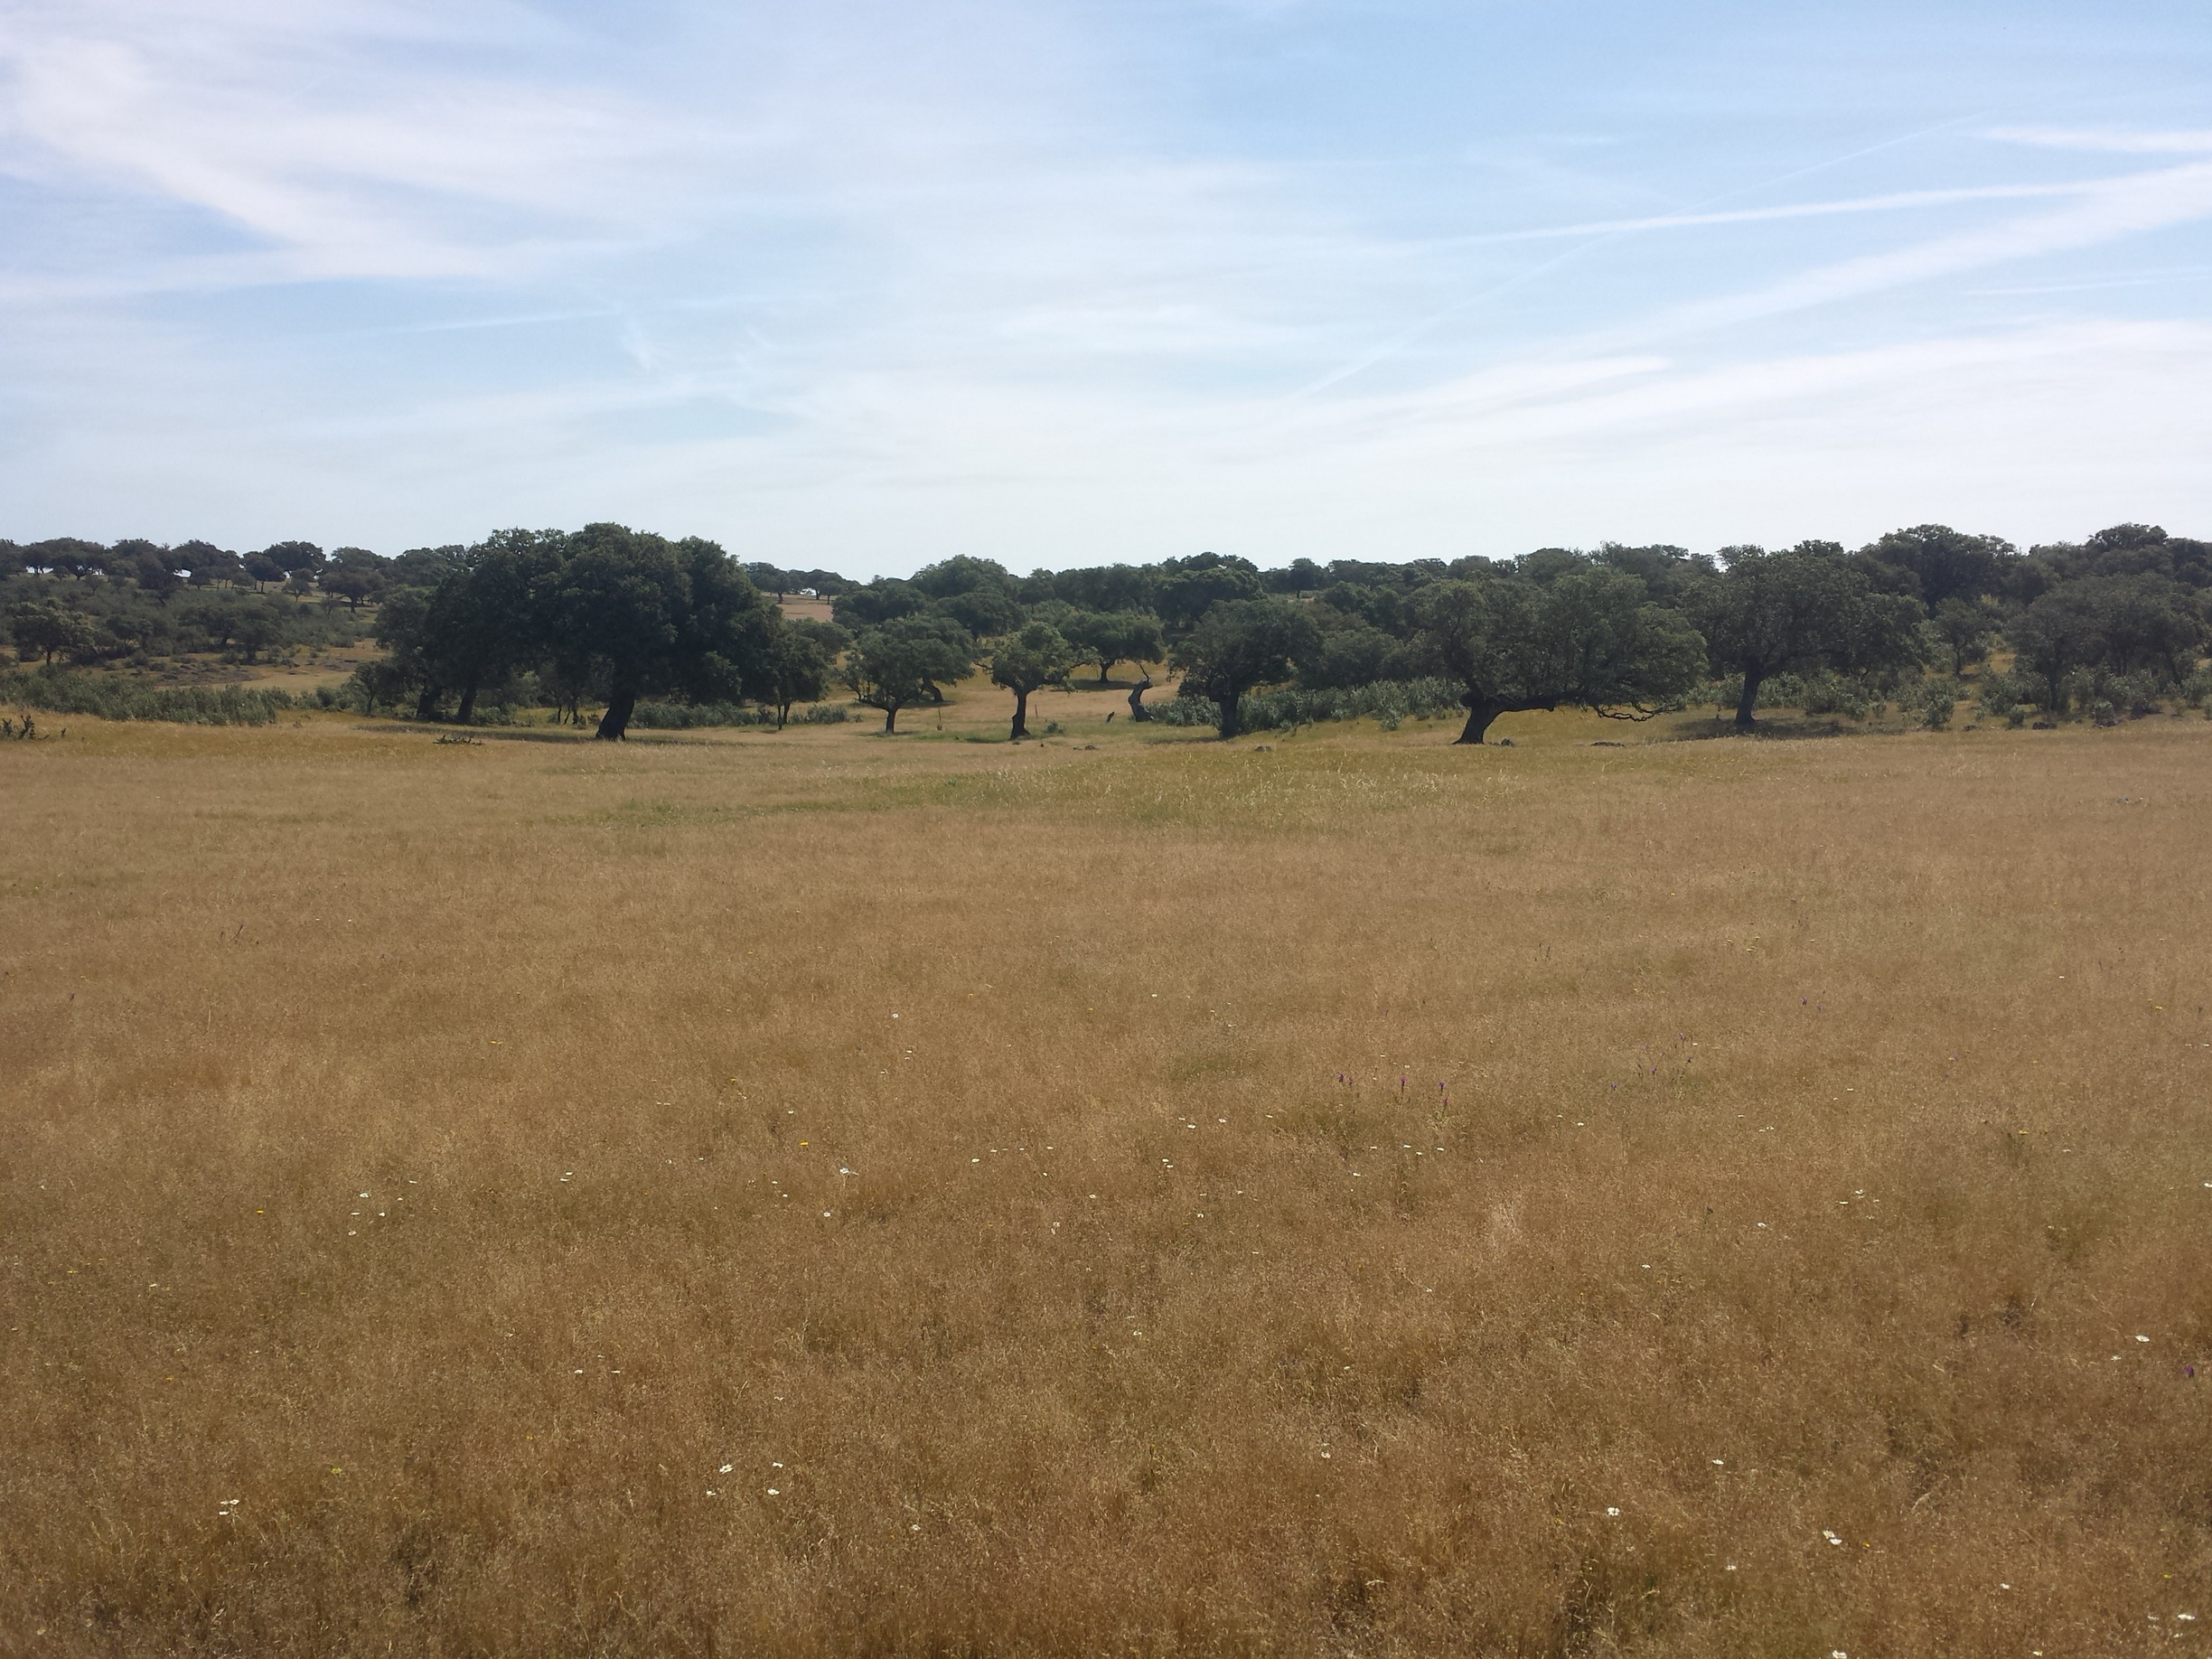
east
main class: Grassland
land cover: Grassland without tree/shrub cover
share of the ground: > 75 %
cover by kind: herbaceous plants 100 %
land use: Agriculture (excluding fallow land and kitchen gardens)
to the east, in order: Grassland without tree/shrub cover; Broadleaved woodland; Fences; Broadleaved woodland
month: May
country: ES
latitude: 39.6154
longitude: -7.1280
